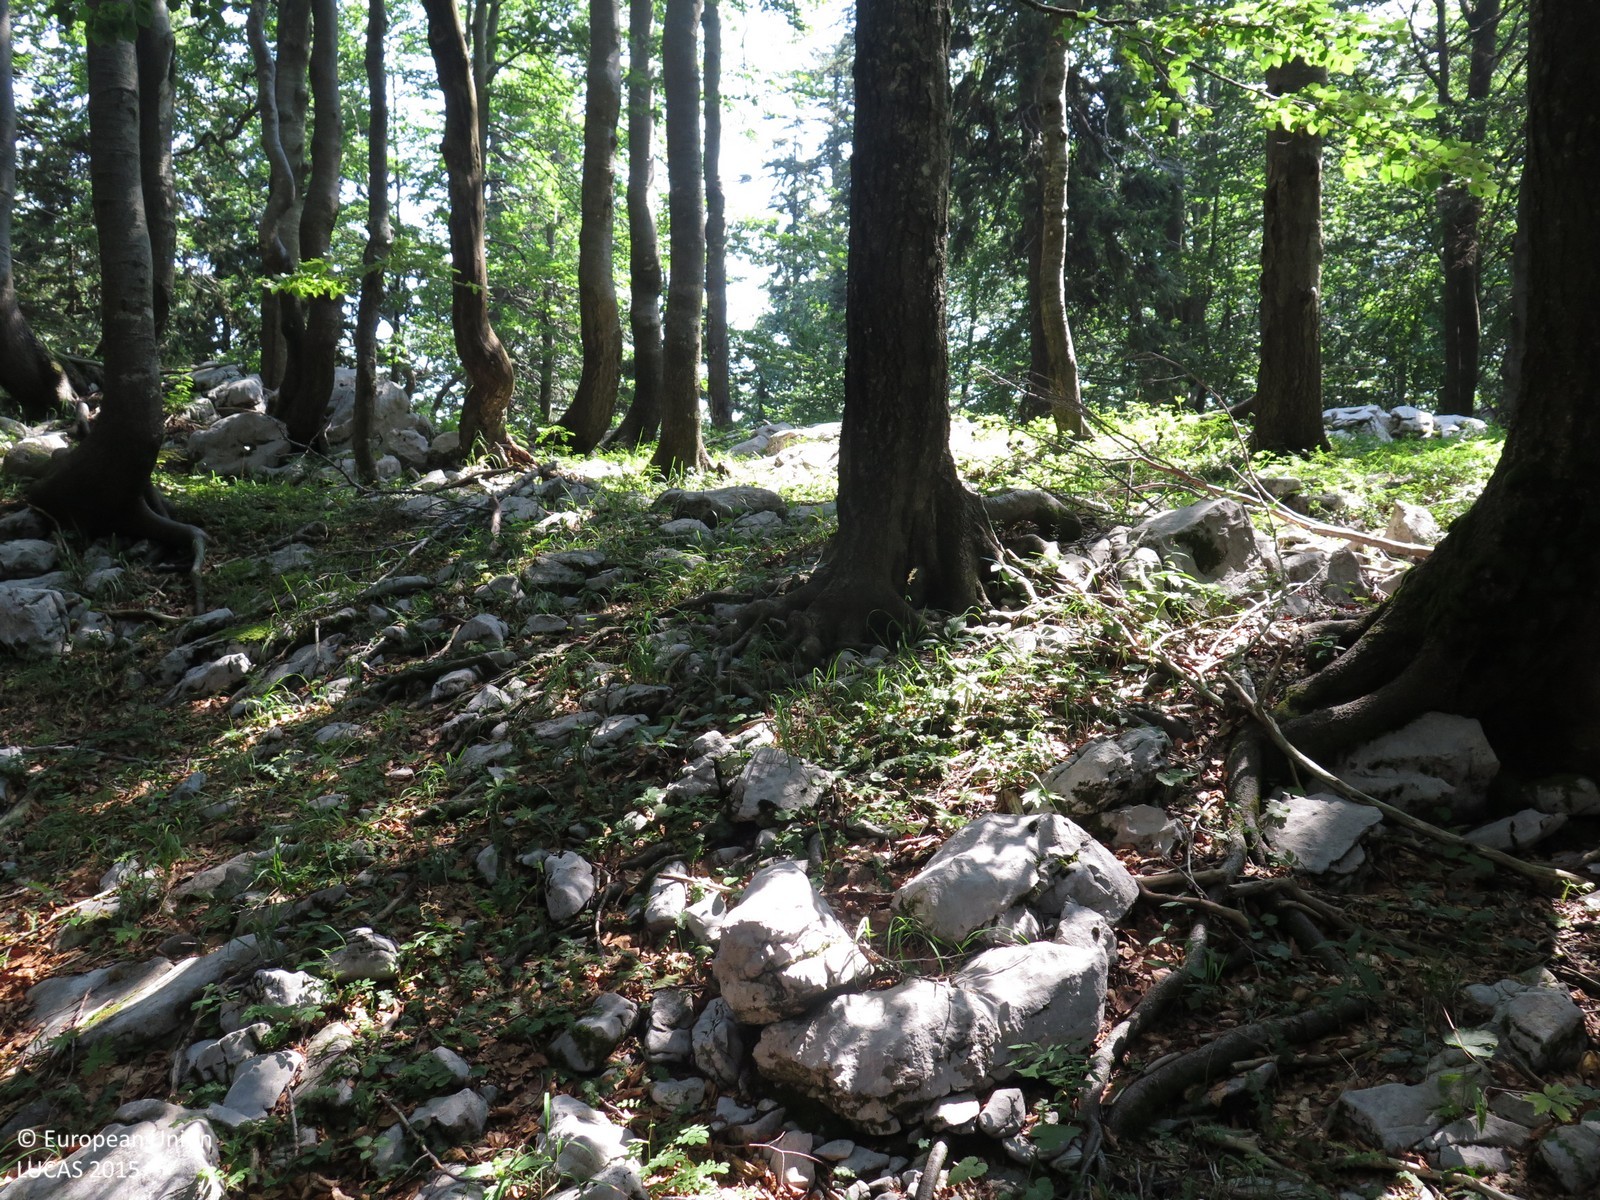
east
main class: Woodland
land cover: Other mixed woodland
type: mountainous beech forest
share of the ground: > 75 %
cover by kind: coniferous forest trees 65 %, broadleaved forest trees 25 %, consolidated bare surface 10 %
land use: Forestry
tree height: > 5 m
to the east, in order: Other mixed woodland; Rocks and stones; Other mixed woodland
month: August
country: HR
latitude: 45.4971
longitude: 14.5383
